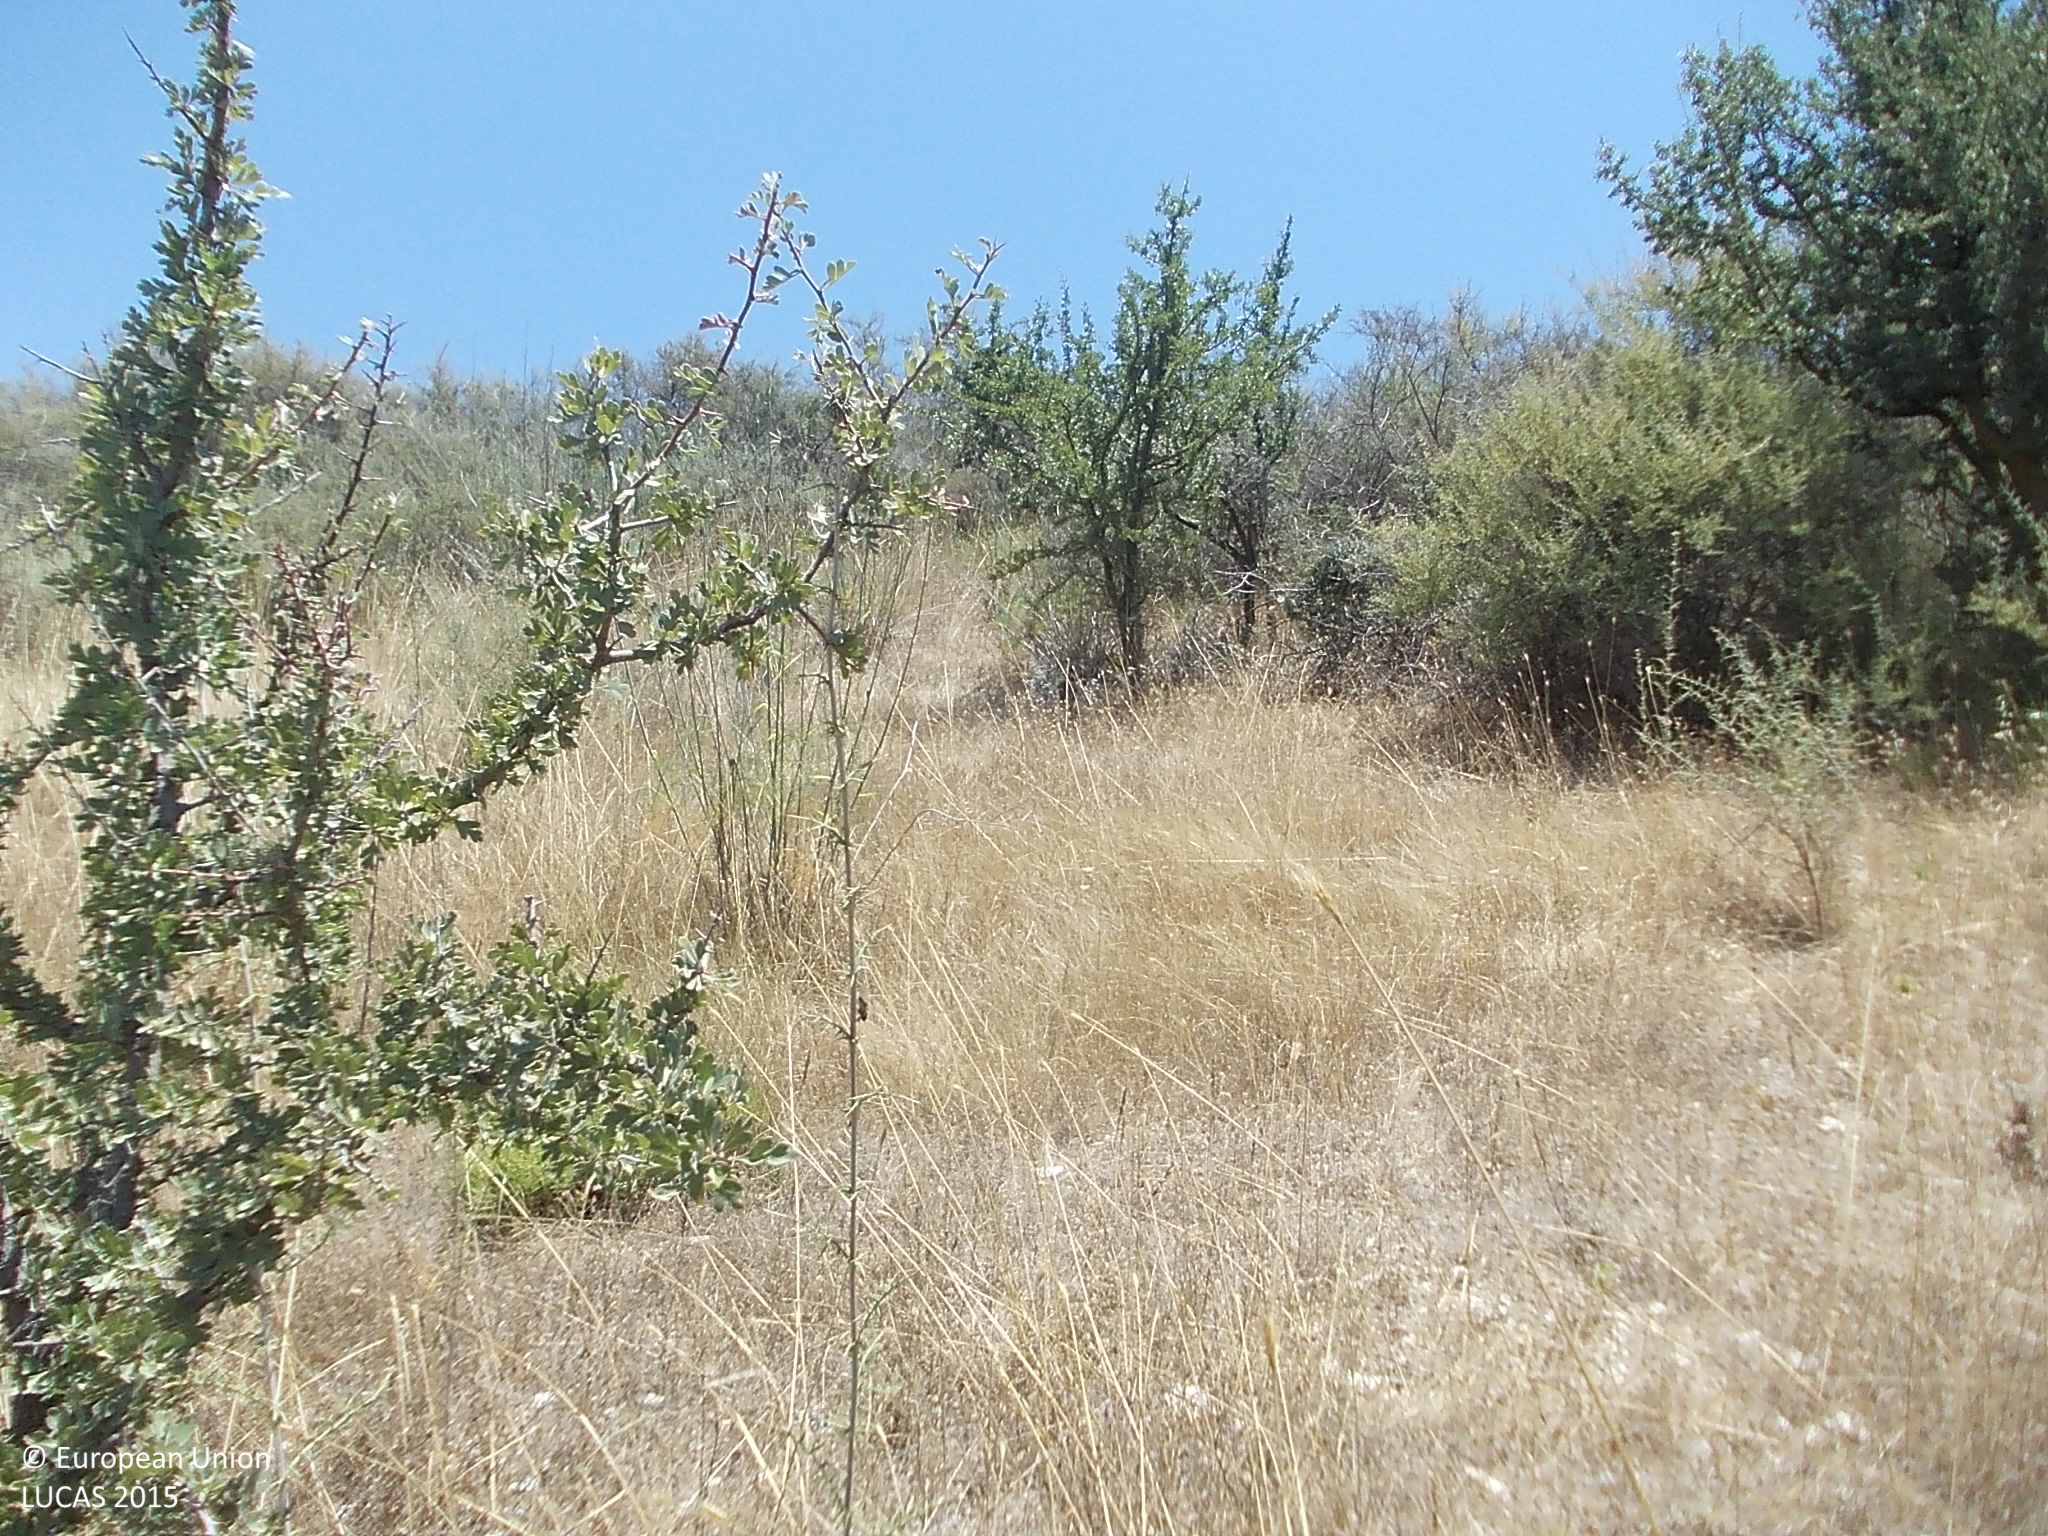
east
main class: Grassland
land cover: Grassland with sparse tree/shrub cover
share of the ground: > 75 %
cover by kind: herbaceous plants 85 %, broadleaved forest trees 5 %, shrubs 5 %, unconsolidated bare surface 5 %
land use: Semi-natural and natural areas not in use
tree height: < 5 m
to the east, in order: Grassland with sparse tree/shrub cover; Shrubland with sparse tree cover; Rivers and streams; Shrubland with sparse tree cover; Grassland with sparse tree/shrub cover; Tracks; Other mixed woodland; Shrubland without tree cover; Other mixed woodland
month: July
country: CY
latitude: 34.8064
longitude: 32.7297
